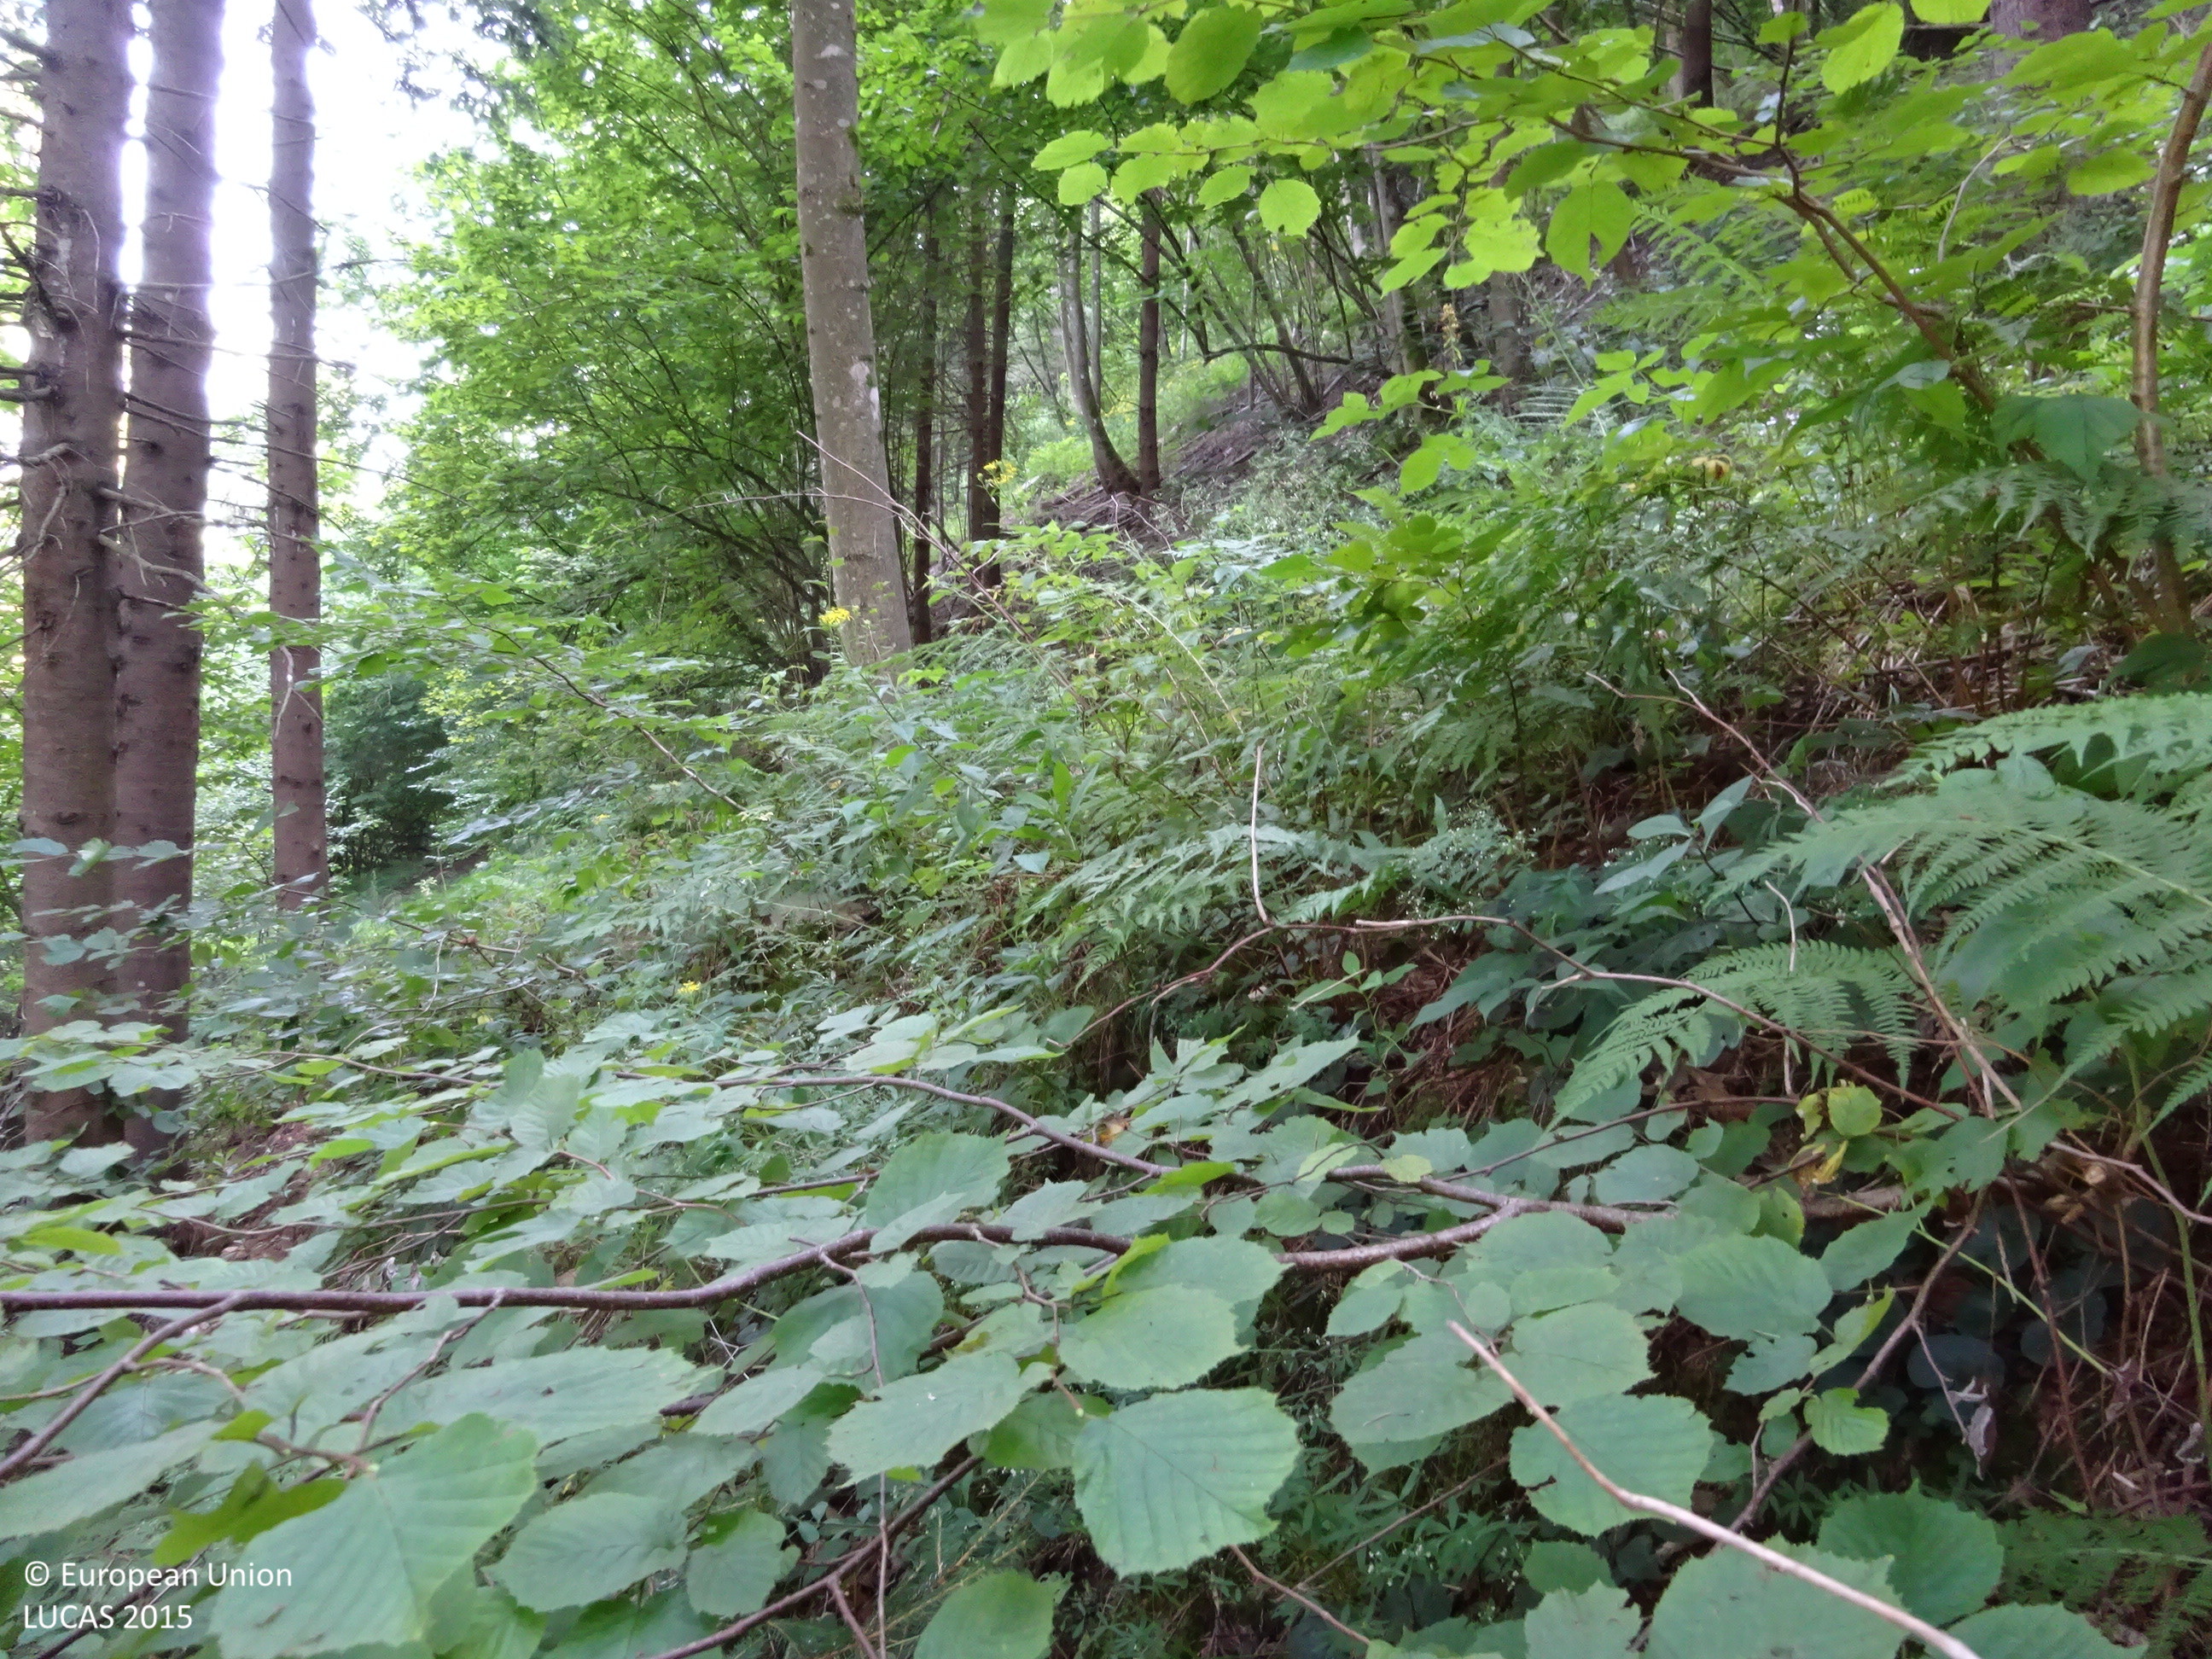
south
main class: Woodland
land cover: Spruce dominated mixed woodland
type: alpine coniferous forest
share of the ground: > 75 %
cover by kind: coniferous forest trees 50 %, broadleaved forest trees 40 %, shrubs 10 %
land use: Forestry
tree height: > 5 m
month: August
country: AT
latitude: 47.4116
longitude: 15.9791
